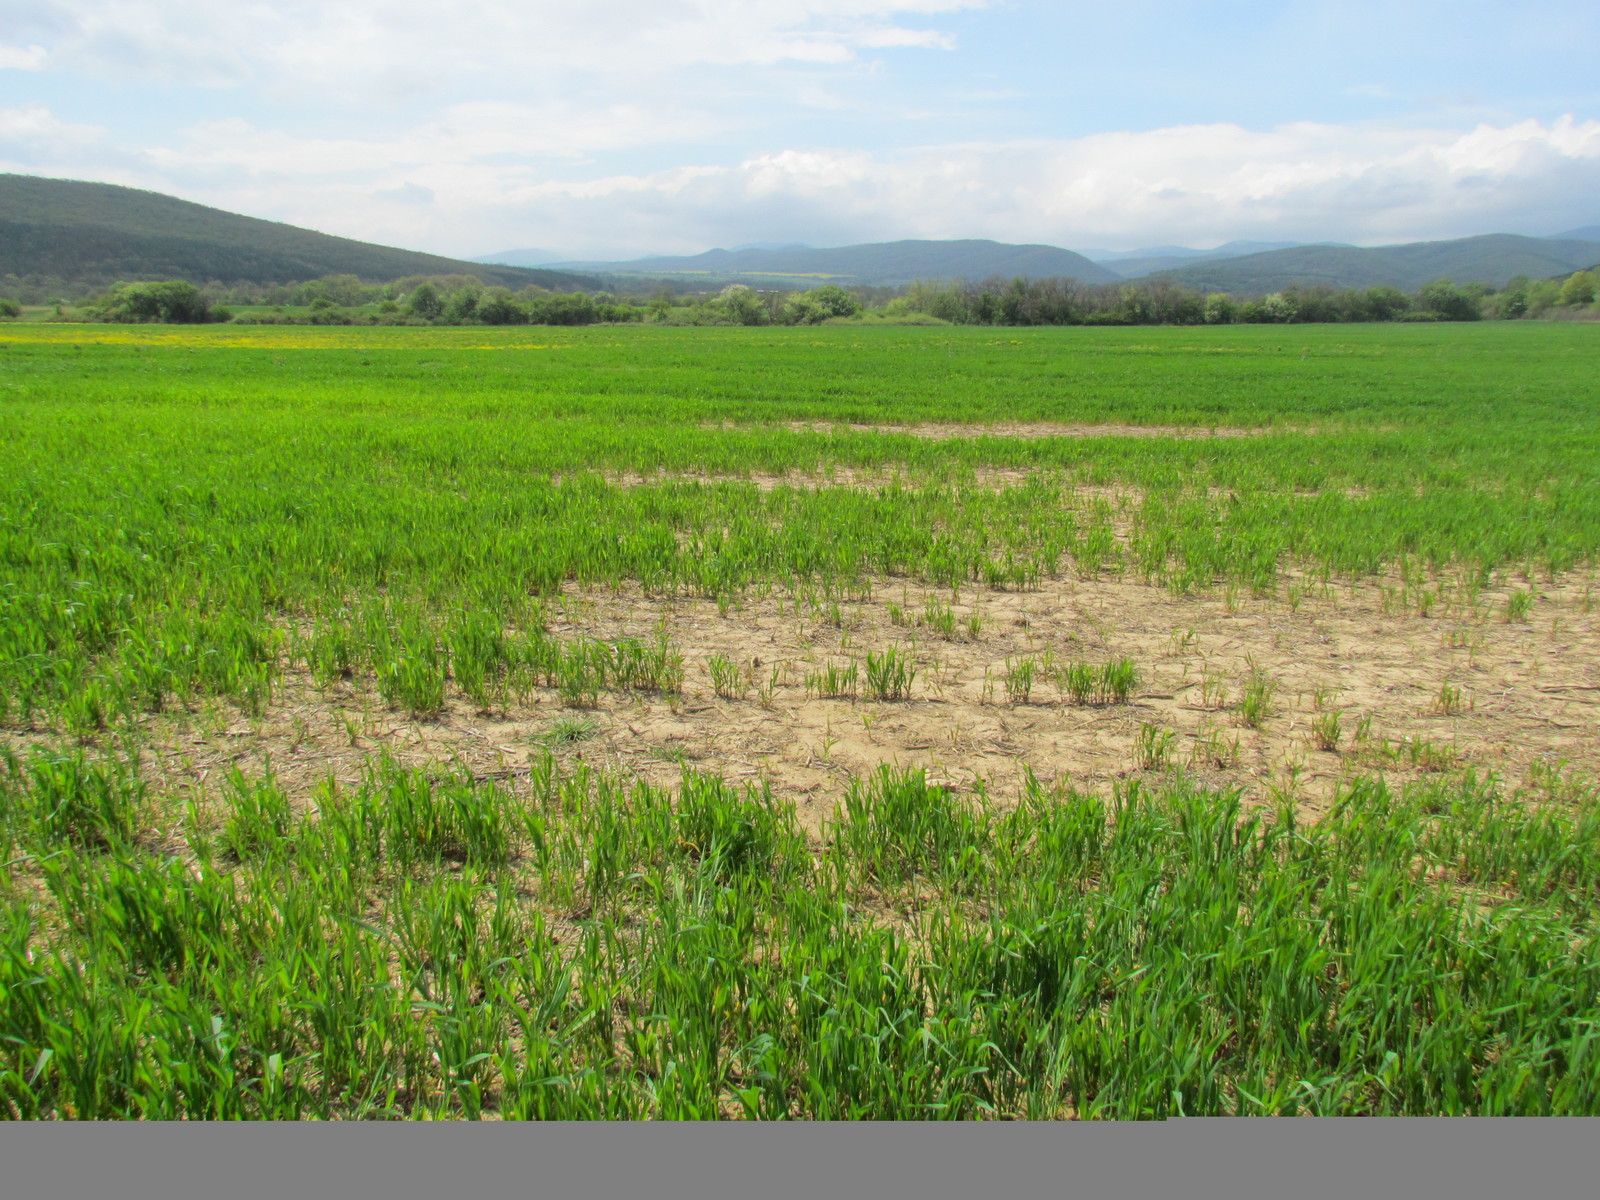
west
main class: Cropland
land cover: Barley
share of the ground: > 75 %
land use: Agriculture (excluding fallow land and kitchen gardens)
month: April
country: BG
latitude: 42.8457
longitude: 26.6560
